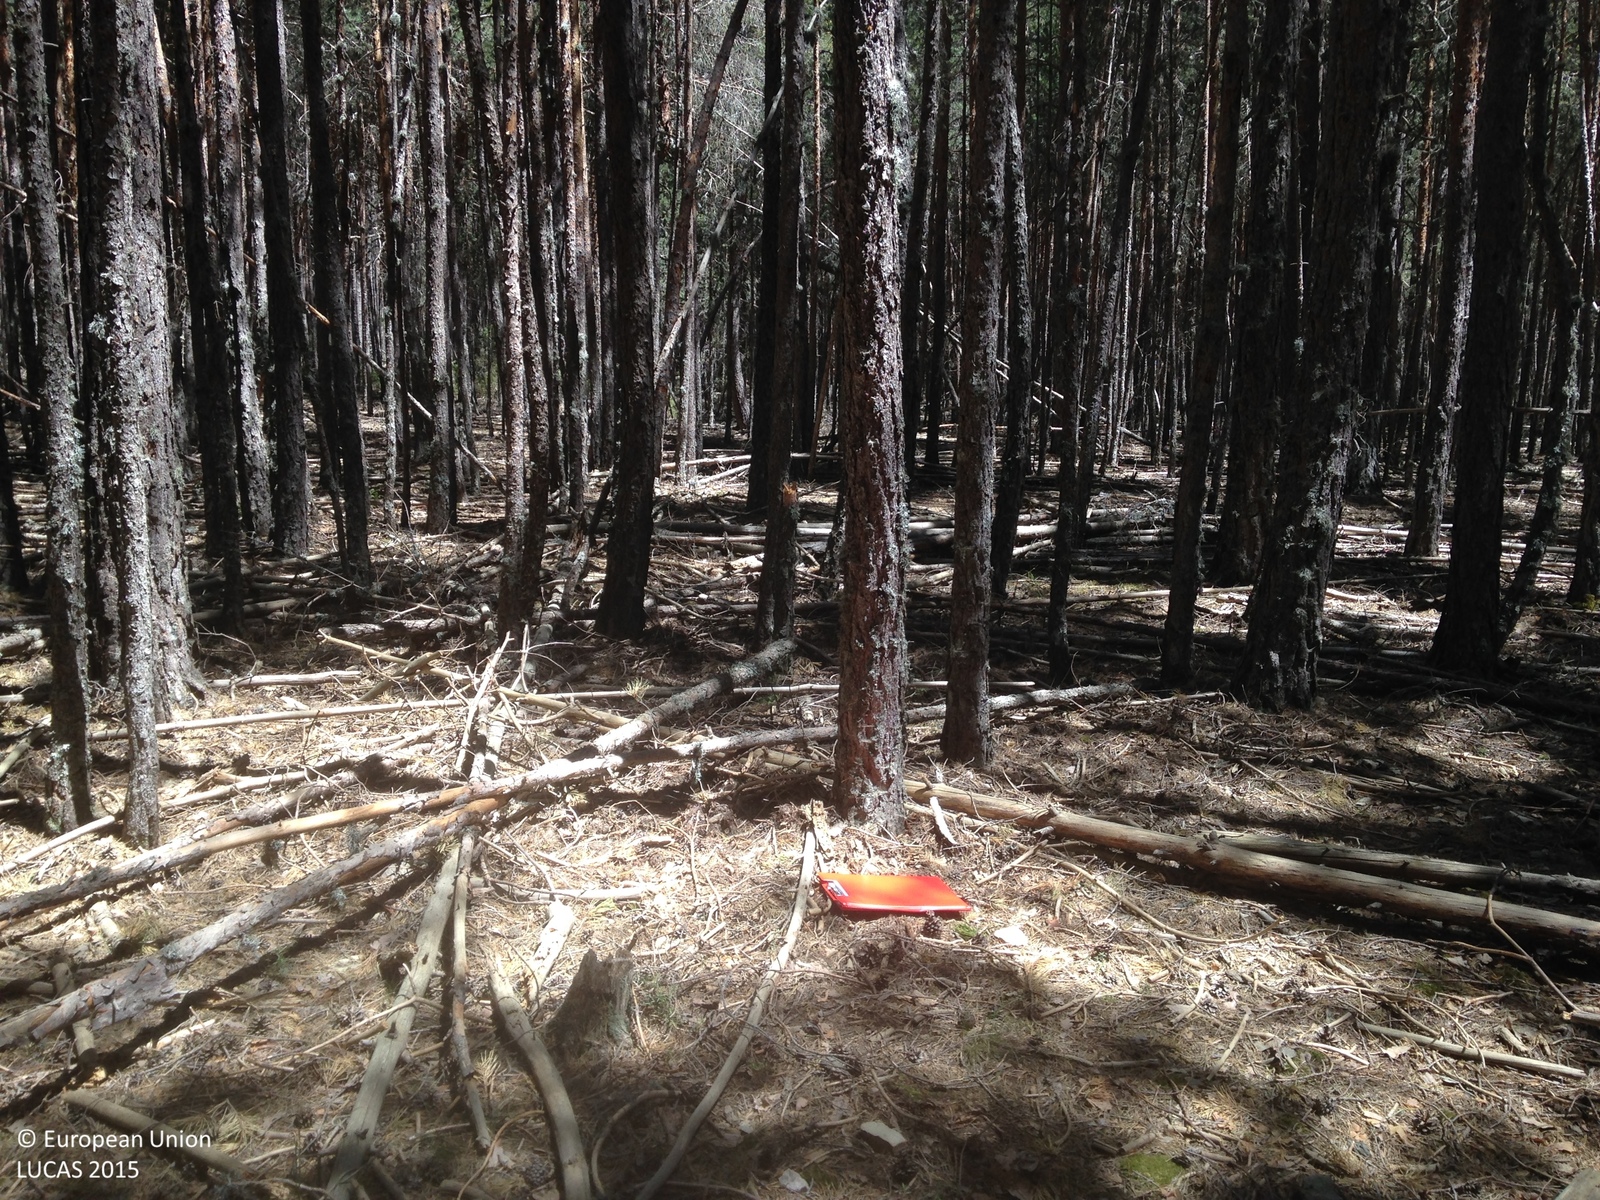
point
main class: Woodland
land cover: Pine dominated coniferous woodland
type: coniferous forest of the mediterranean region
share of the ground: > 75 %
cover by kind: coniferous forest trees 90 %
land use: Forestry
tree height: > 5 m
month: May
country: ES
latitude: 40.5530
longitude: -1.9825
